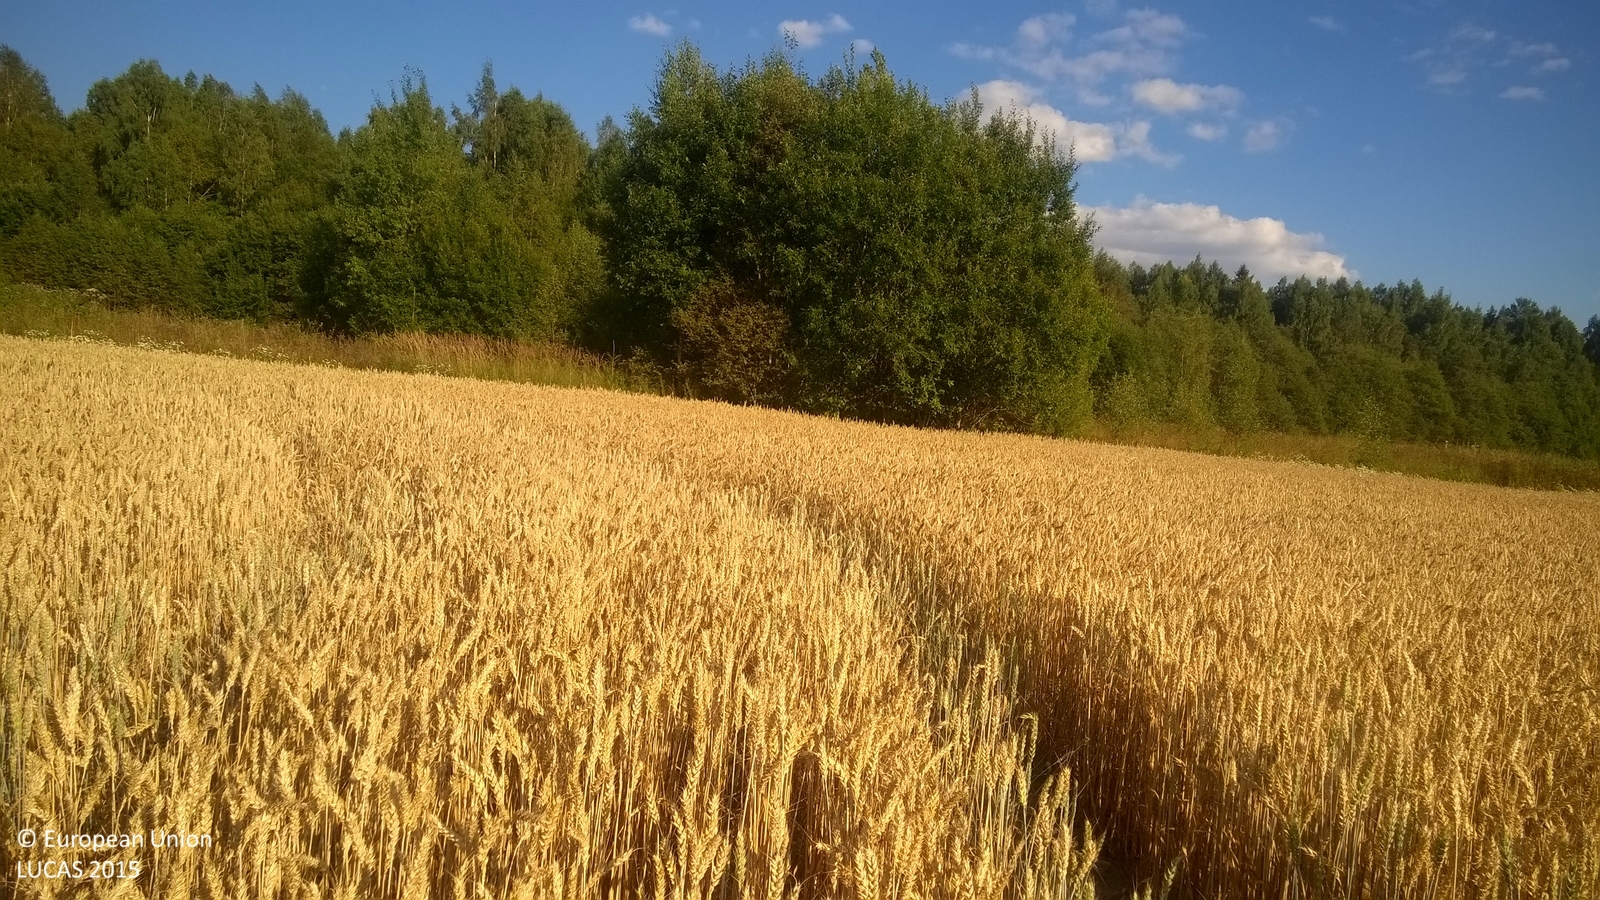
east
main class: Cropland
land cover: Common wheat
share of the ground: > 75 %
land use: Agriculture (excluding fallow land and kitchen gardens)
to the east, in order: Common wheat; Spontaneously vegetated surfaces; Broadleaved woodland; Ditches and canals; Broadleaved woodland
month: August
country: LV
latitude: 57.8745
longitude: 25.7142
